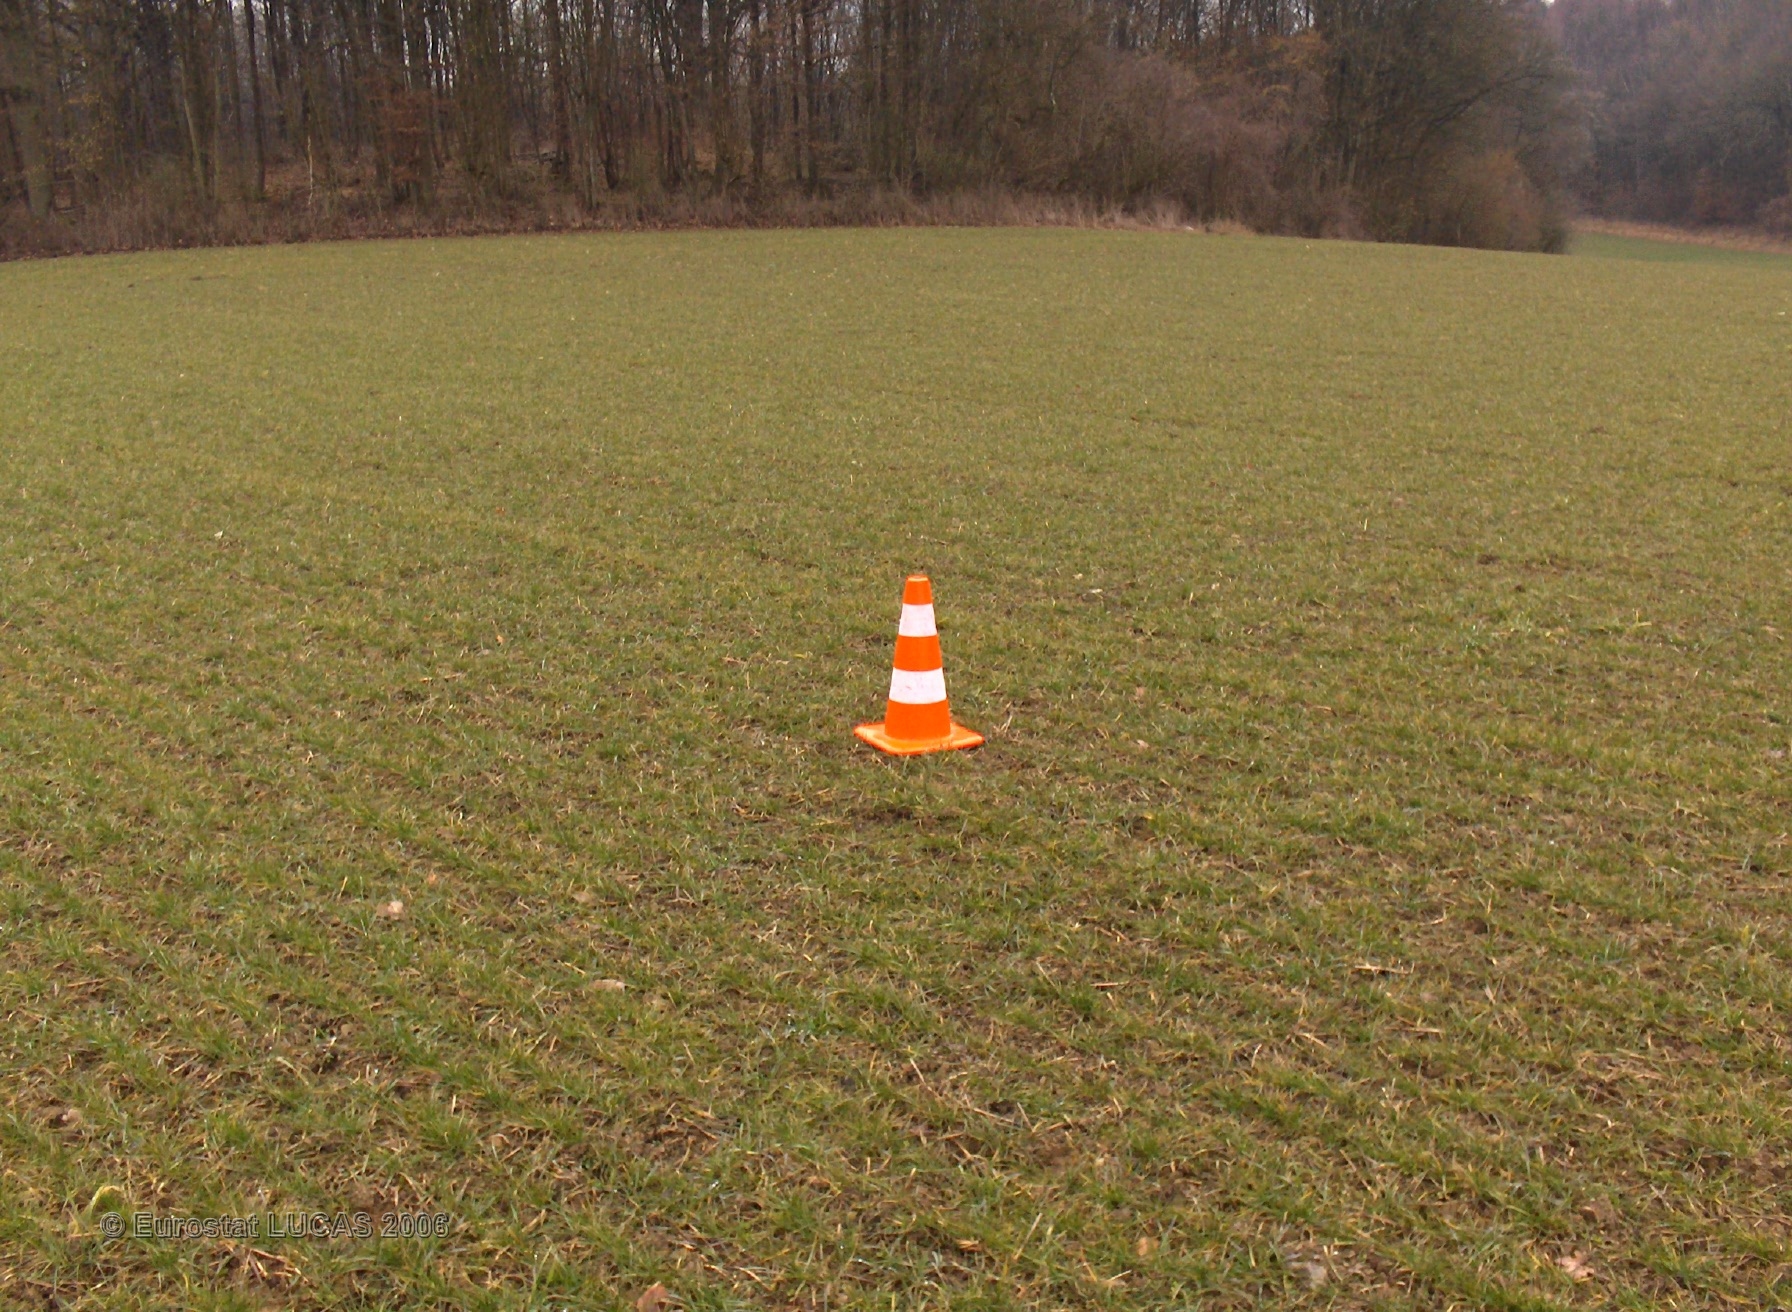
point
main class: Grassland
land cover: Grassland without tree/shrub cover
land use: Agriculture (excluding fallow land and kitchen gardens)
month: March
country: BE
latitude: 50.4827
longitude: 5.2766
